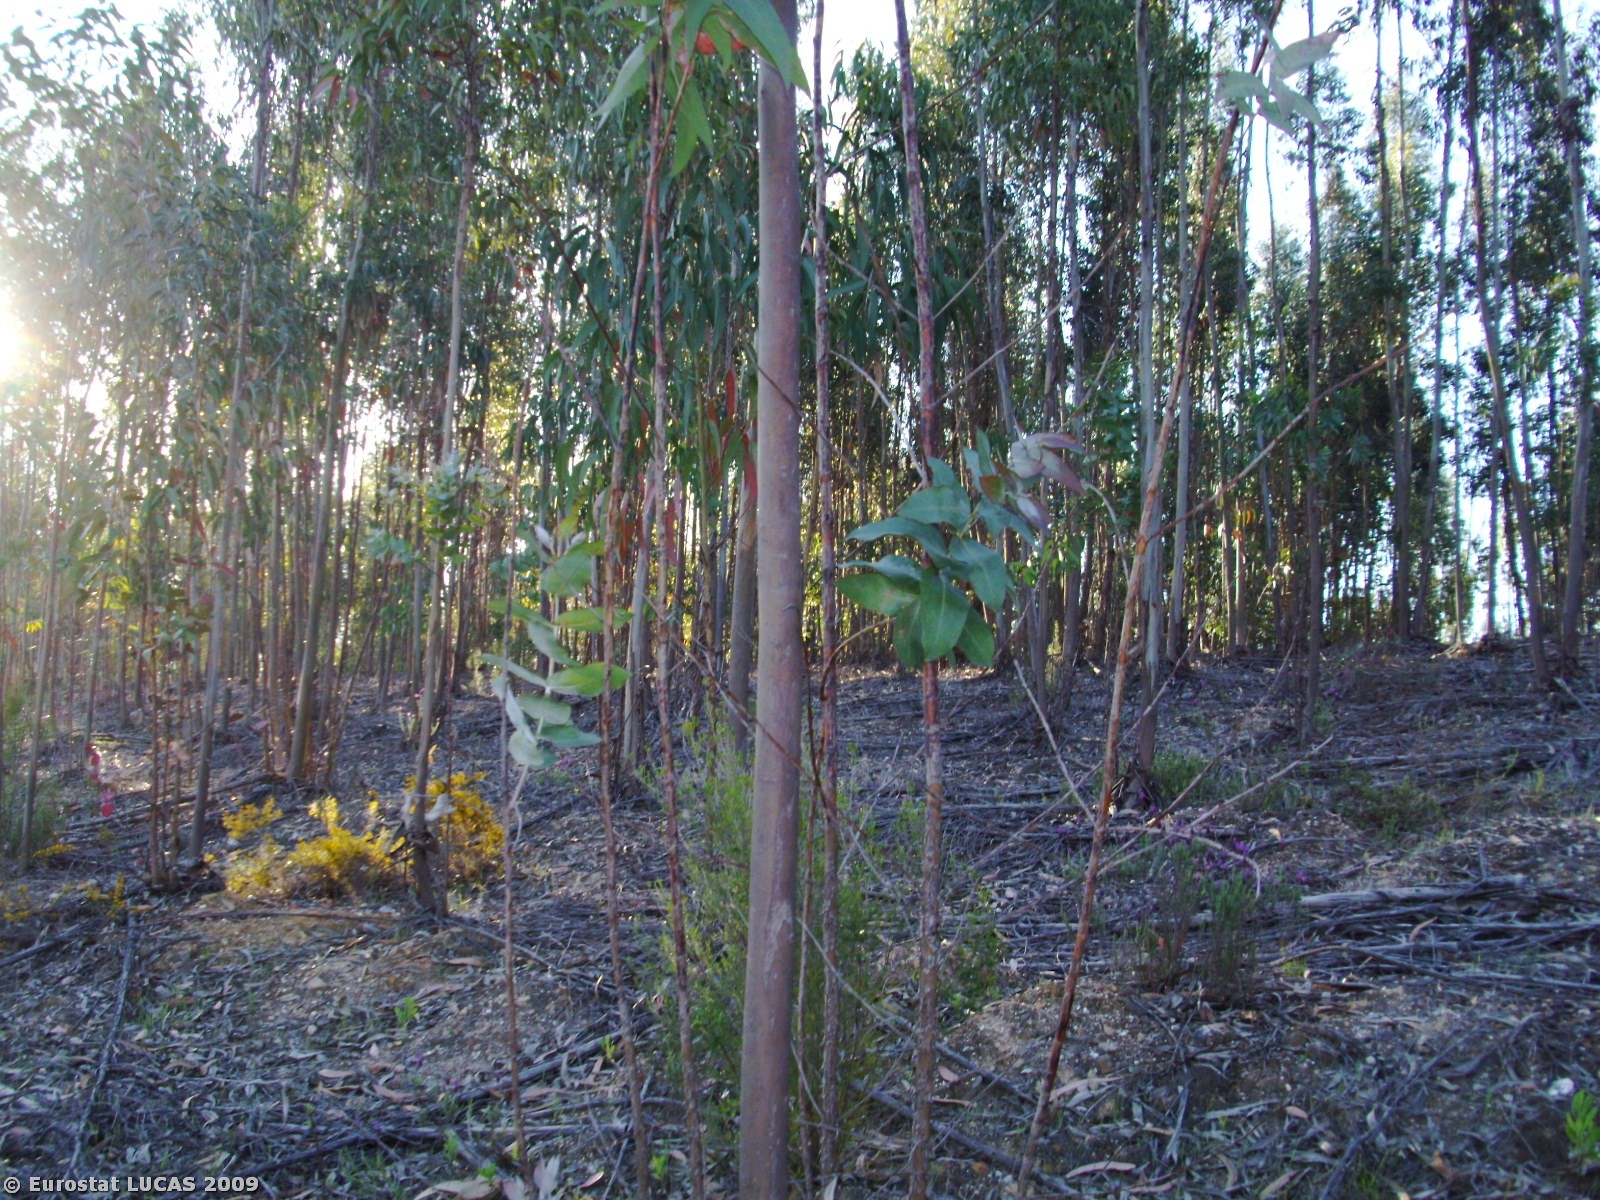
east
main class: Woodland
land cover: Broadleaved woodland
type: plantations and self-sown exotic forest
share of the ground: > 75 %
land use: Forestry
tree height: > 5 m
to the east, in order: Broadleaved woodland; Tracks; Broadleaved woodland
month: May
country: PT
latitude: 39.6862
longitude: -7.5532
